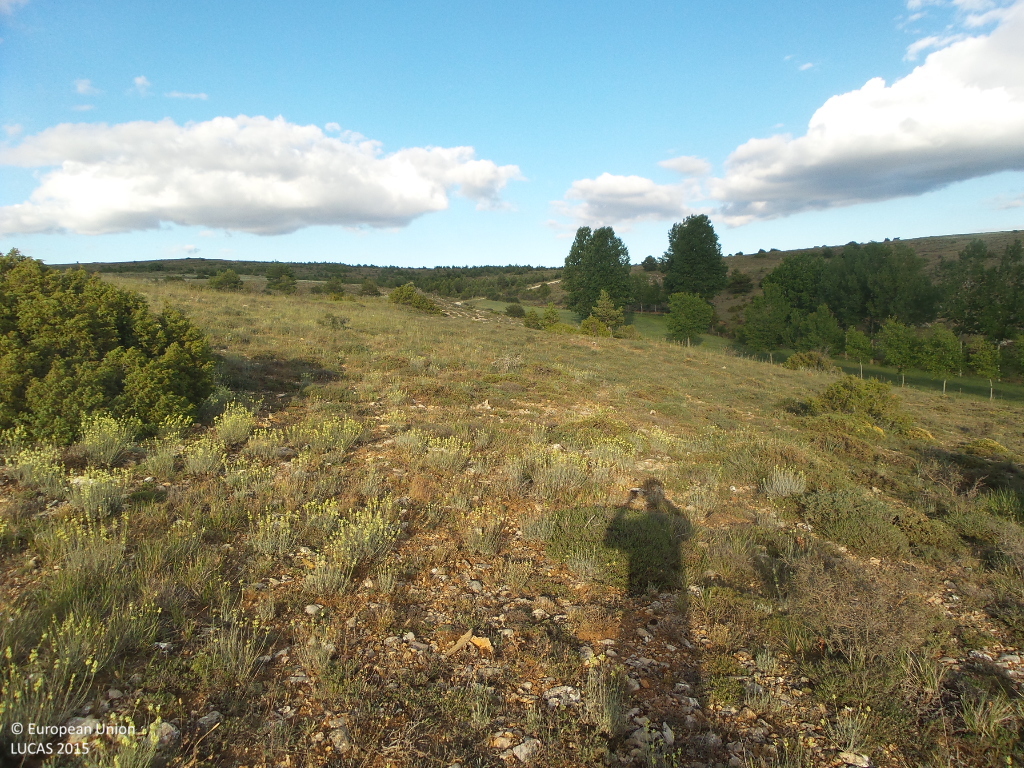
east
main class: Shrubland
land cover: Shrubland with sparse tree cover
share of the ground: 50 - 75 %
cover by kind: shrubs 65 %, unconsolidated bare surface 30 %, coniferous forest trees 5 %
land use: Semi-natural and natural areas not in use
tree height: < 5 m
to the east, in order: Shrubland with sparse tree cover; Shrubland without tree cover; Shrubland with sparse tree cover
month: June
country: ES
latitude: 41.2676
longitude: -3.1112
